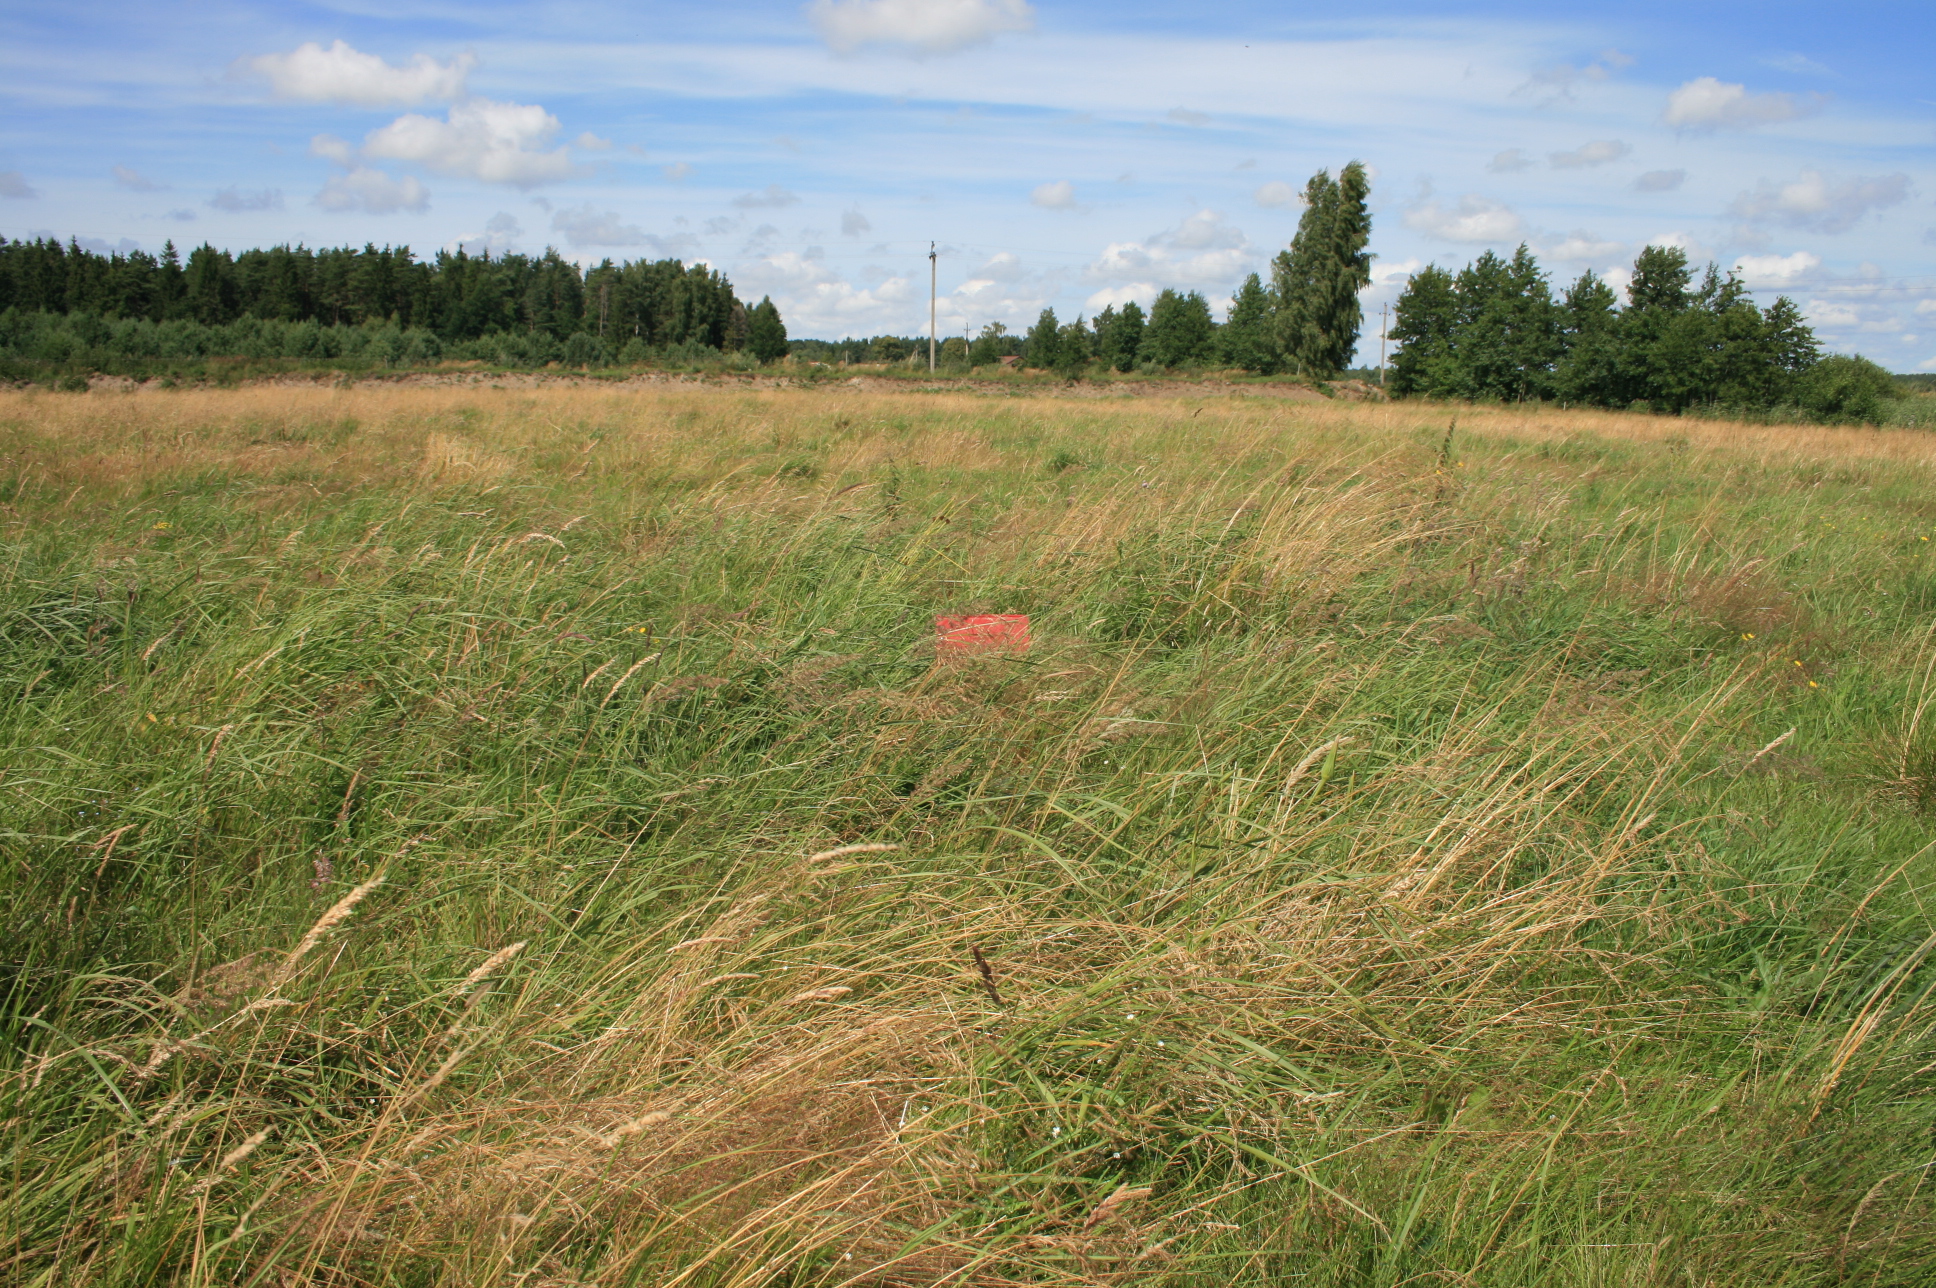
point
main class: Grassland
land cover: Grassland without tree/shrub cover
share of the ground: > 75 %
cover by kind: herbaceous plants 100 %
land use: Agriculture (excluding fallow land and kitchen gardens)
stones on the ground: < 10 %
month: July
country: LT
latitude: 55.5433
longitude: 21.2790
